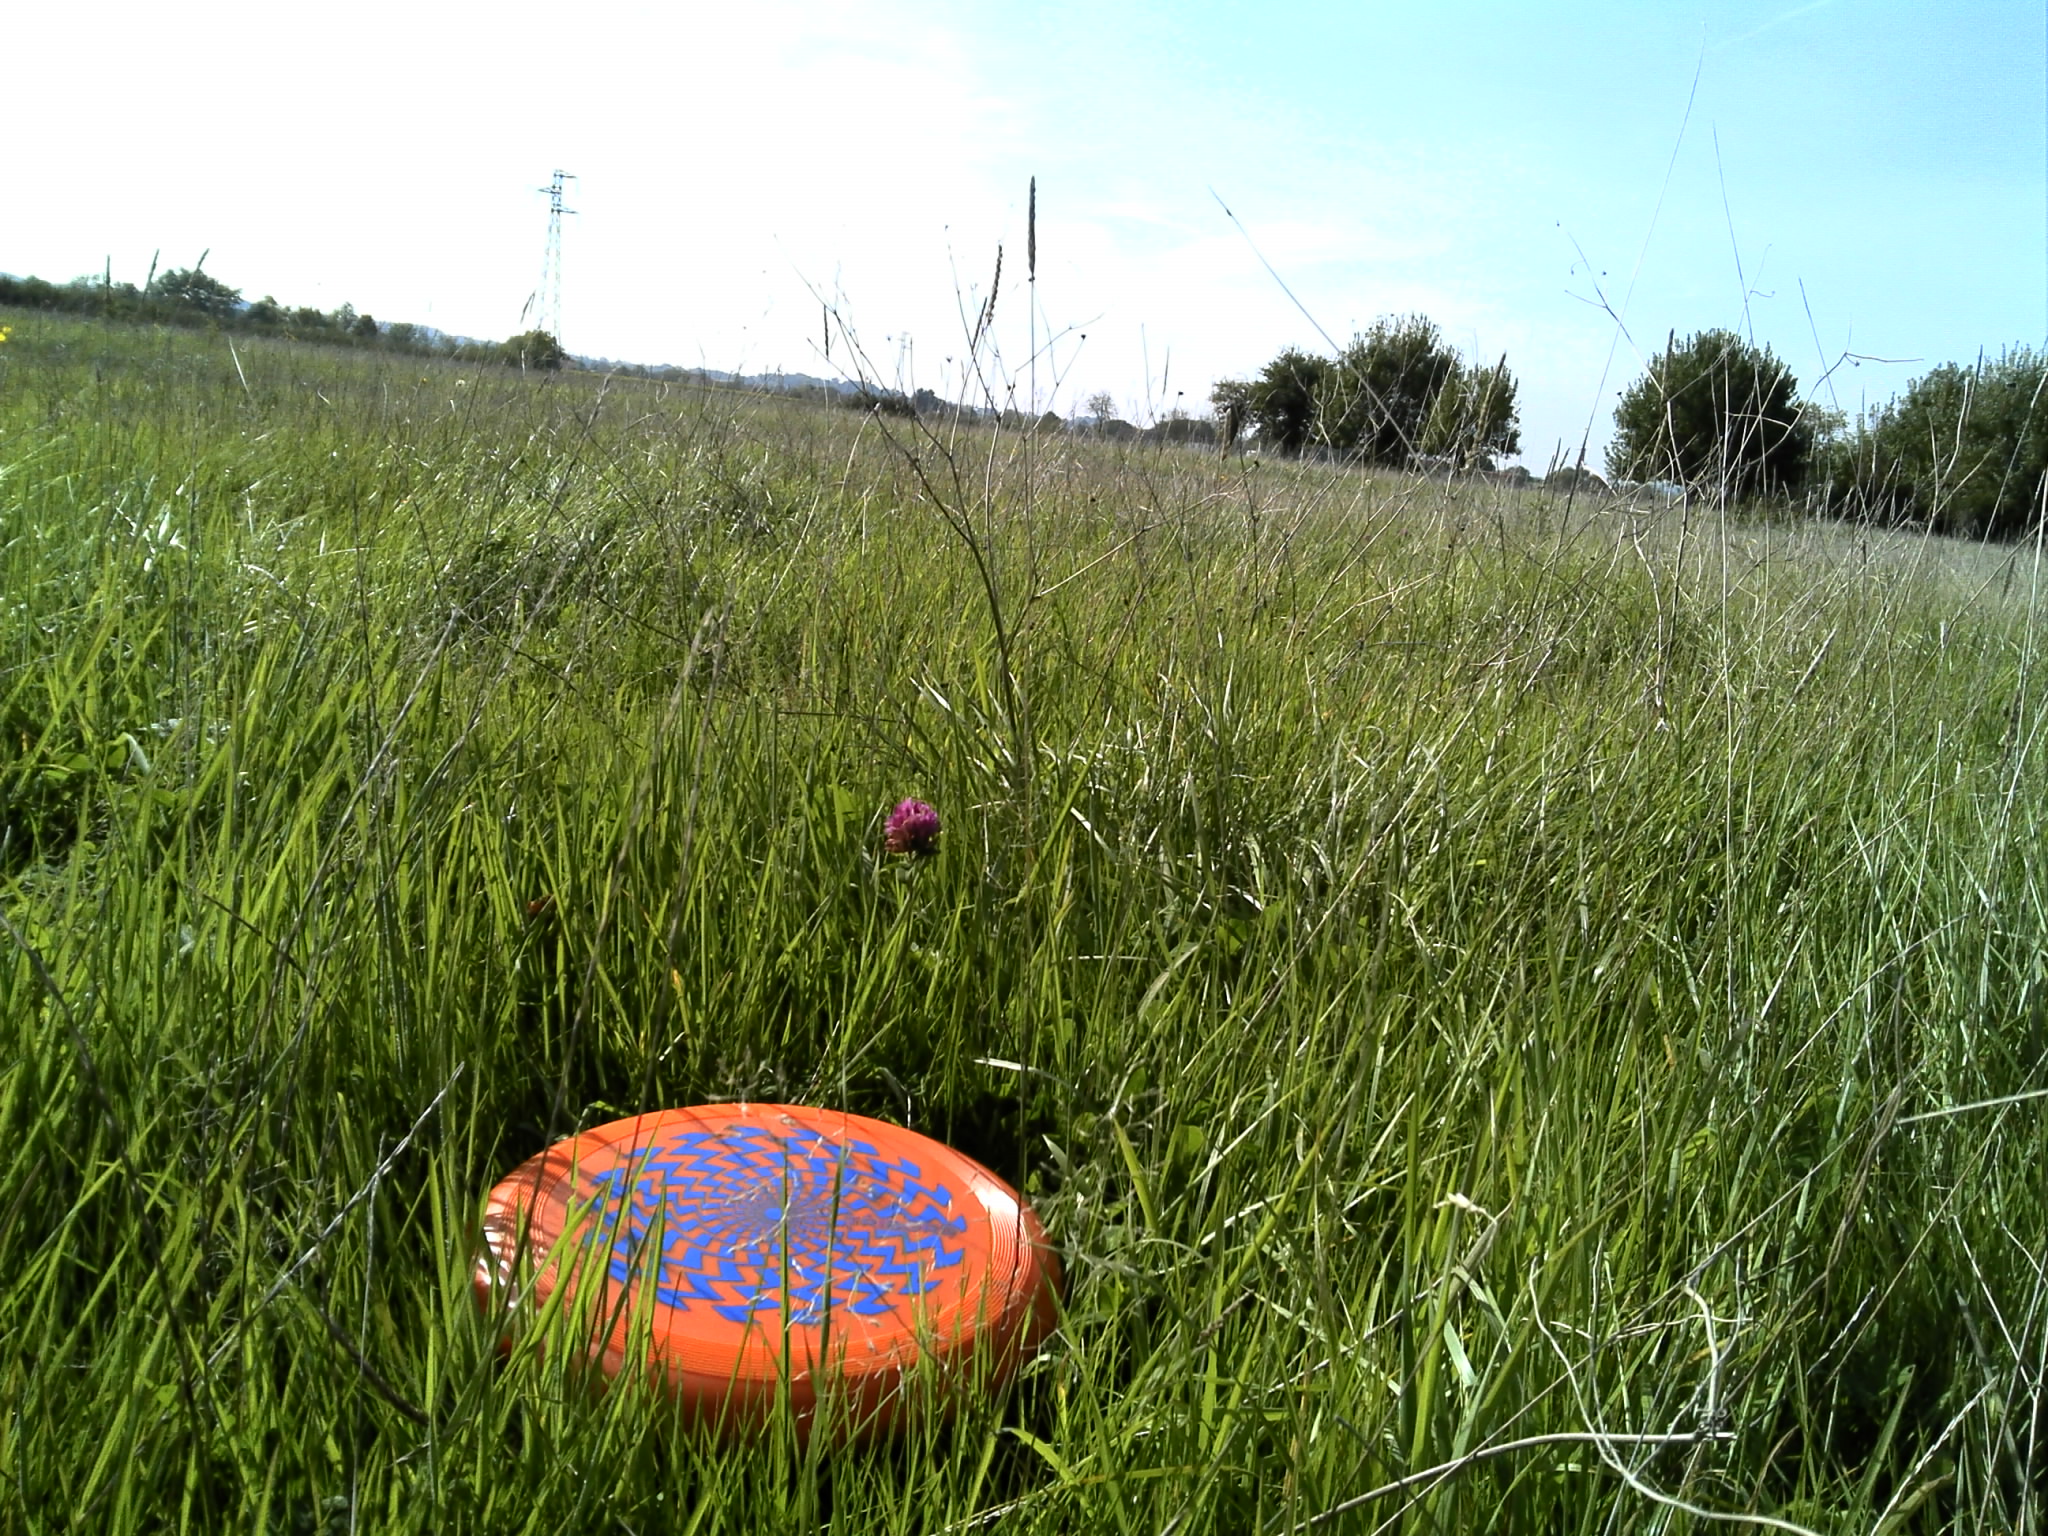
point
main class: Grassland
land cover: Grassland without tree/shrub cover
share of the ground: > 75 %
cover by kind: herbaceous plants 100 %
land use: Agriculture (excluding fallow land and kitchen gardens)
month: October
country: FR
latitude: 47.3165
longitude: -1.2707
